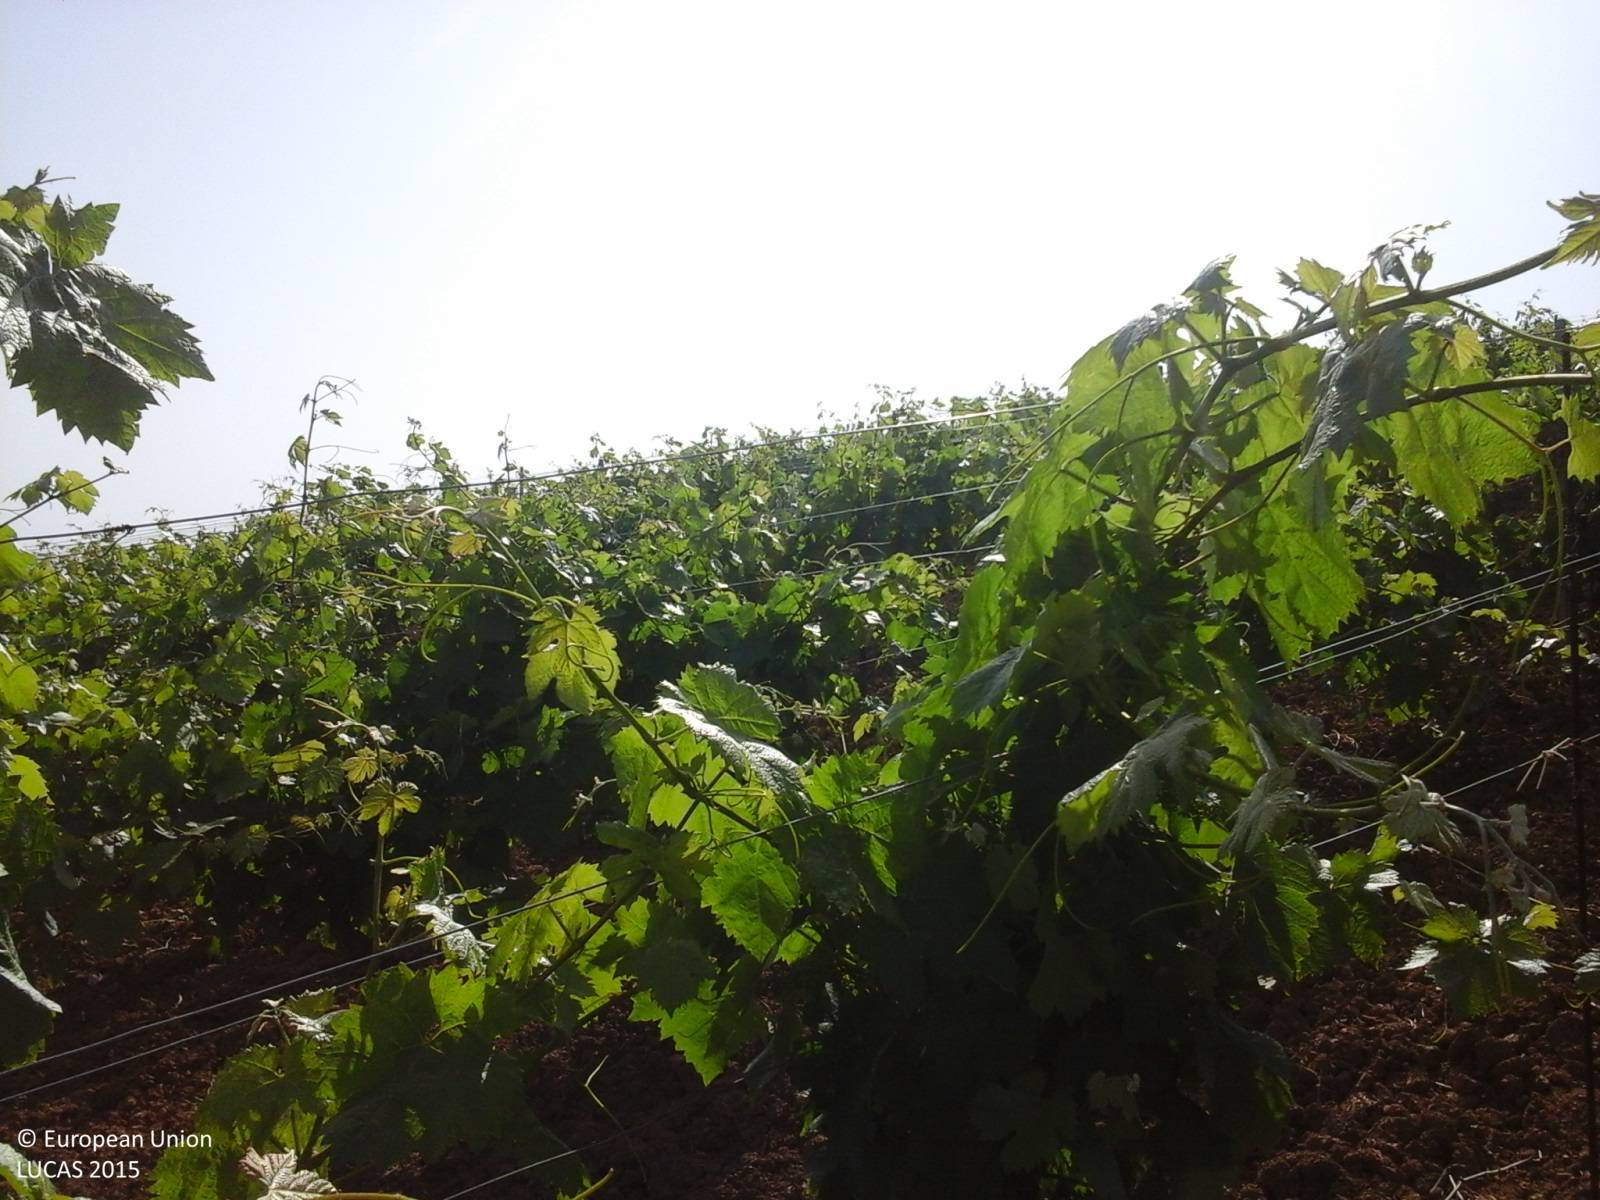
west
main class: Cropland
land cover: Vineyards
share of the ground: 50 - 75 %
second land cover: Other bare soil
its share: > 75 %
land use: Agriculture (excluding fallow land and kitchen gardens)
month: May
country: IT
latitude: 37.8974
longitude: 13.0822
